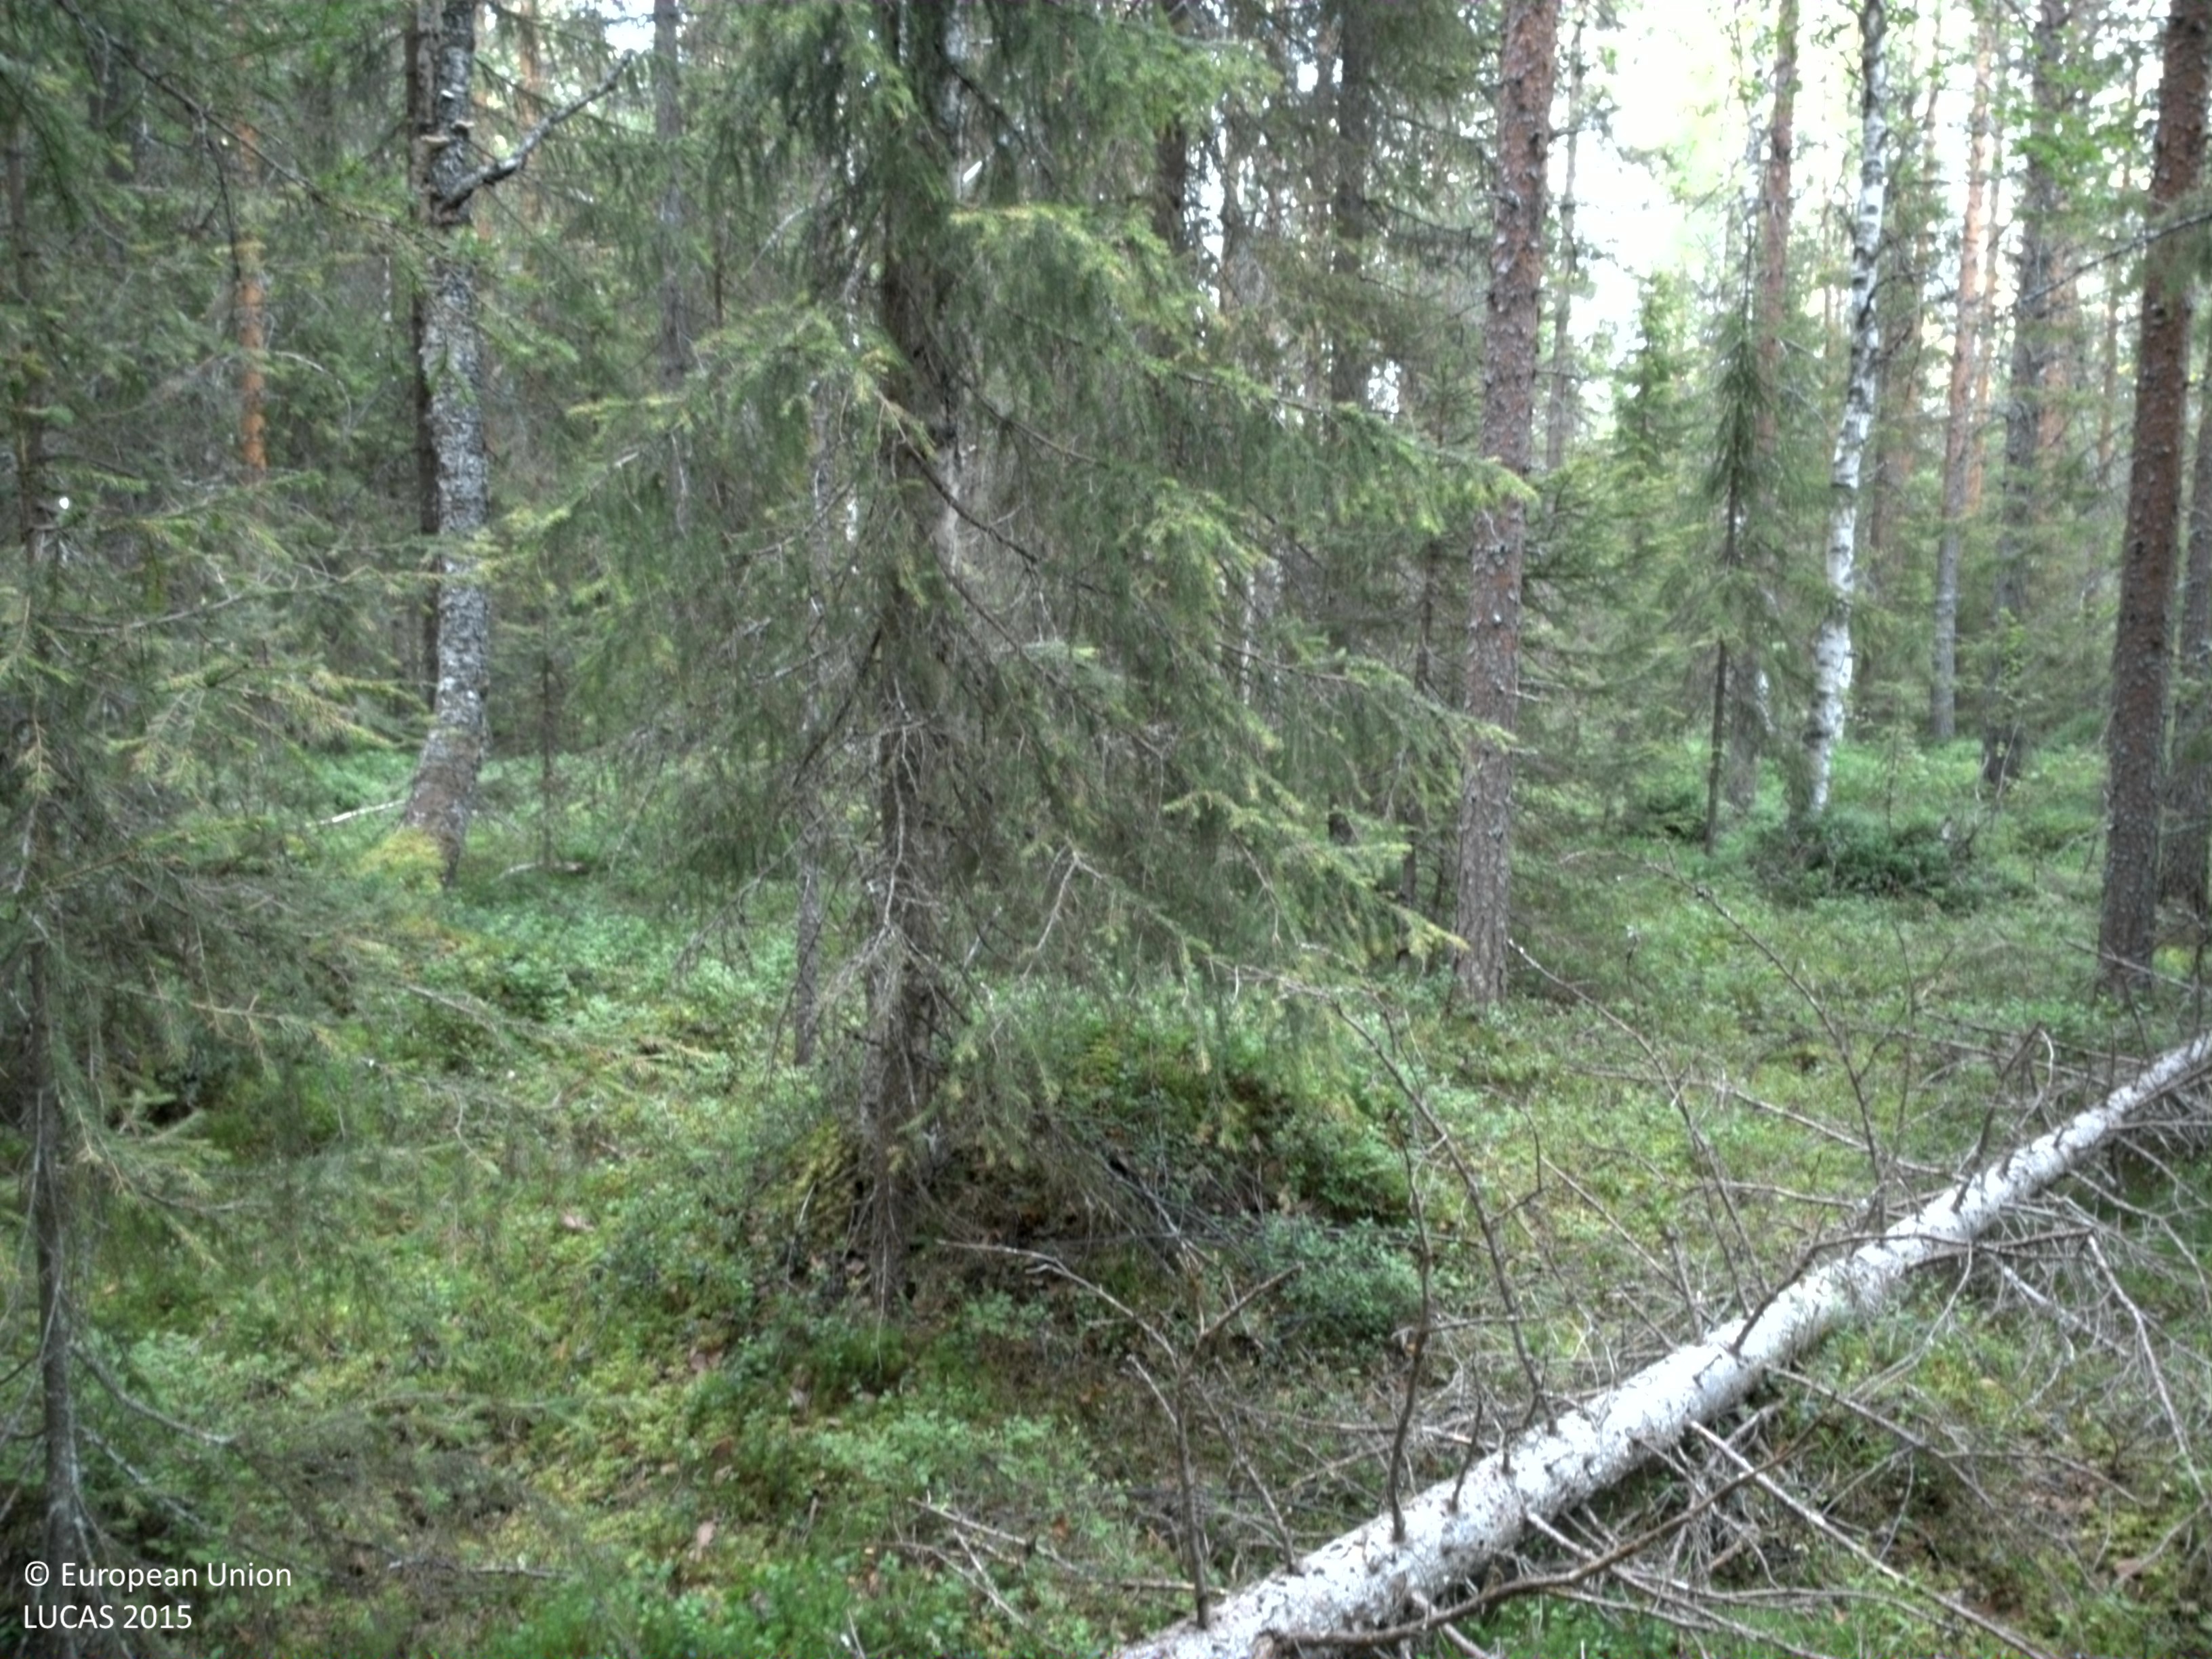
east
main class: Woodland
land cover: Other coniferous woodland
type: boreal forest
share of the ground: 25 - 50 %
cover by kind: shrubs 60 %, coniferous forest trees 40 %
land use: Forestry
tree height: > 5 m
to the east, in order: Other coniferous woodland; Pine dominated coniferous woodland; Shrubland with sparse tree cover; Electric lines; Shrubland with sparse tree cover; Ditches and canals; Pine dominated mixed woodland
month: August
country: SE
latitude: 66.2100
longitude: 22.7976
